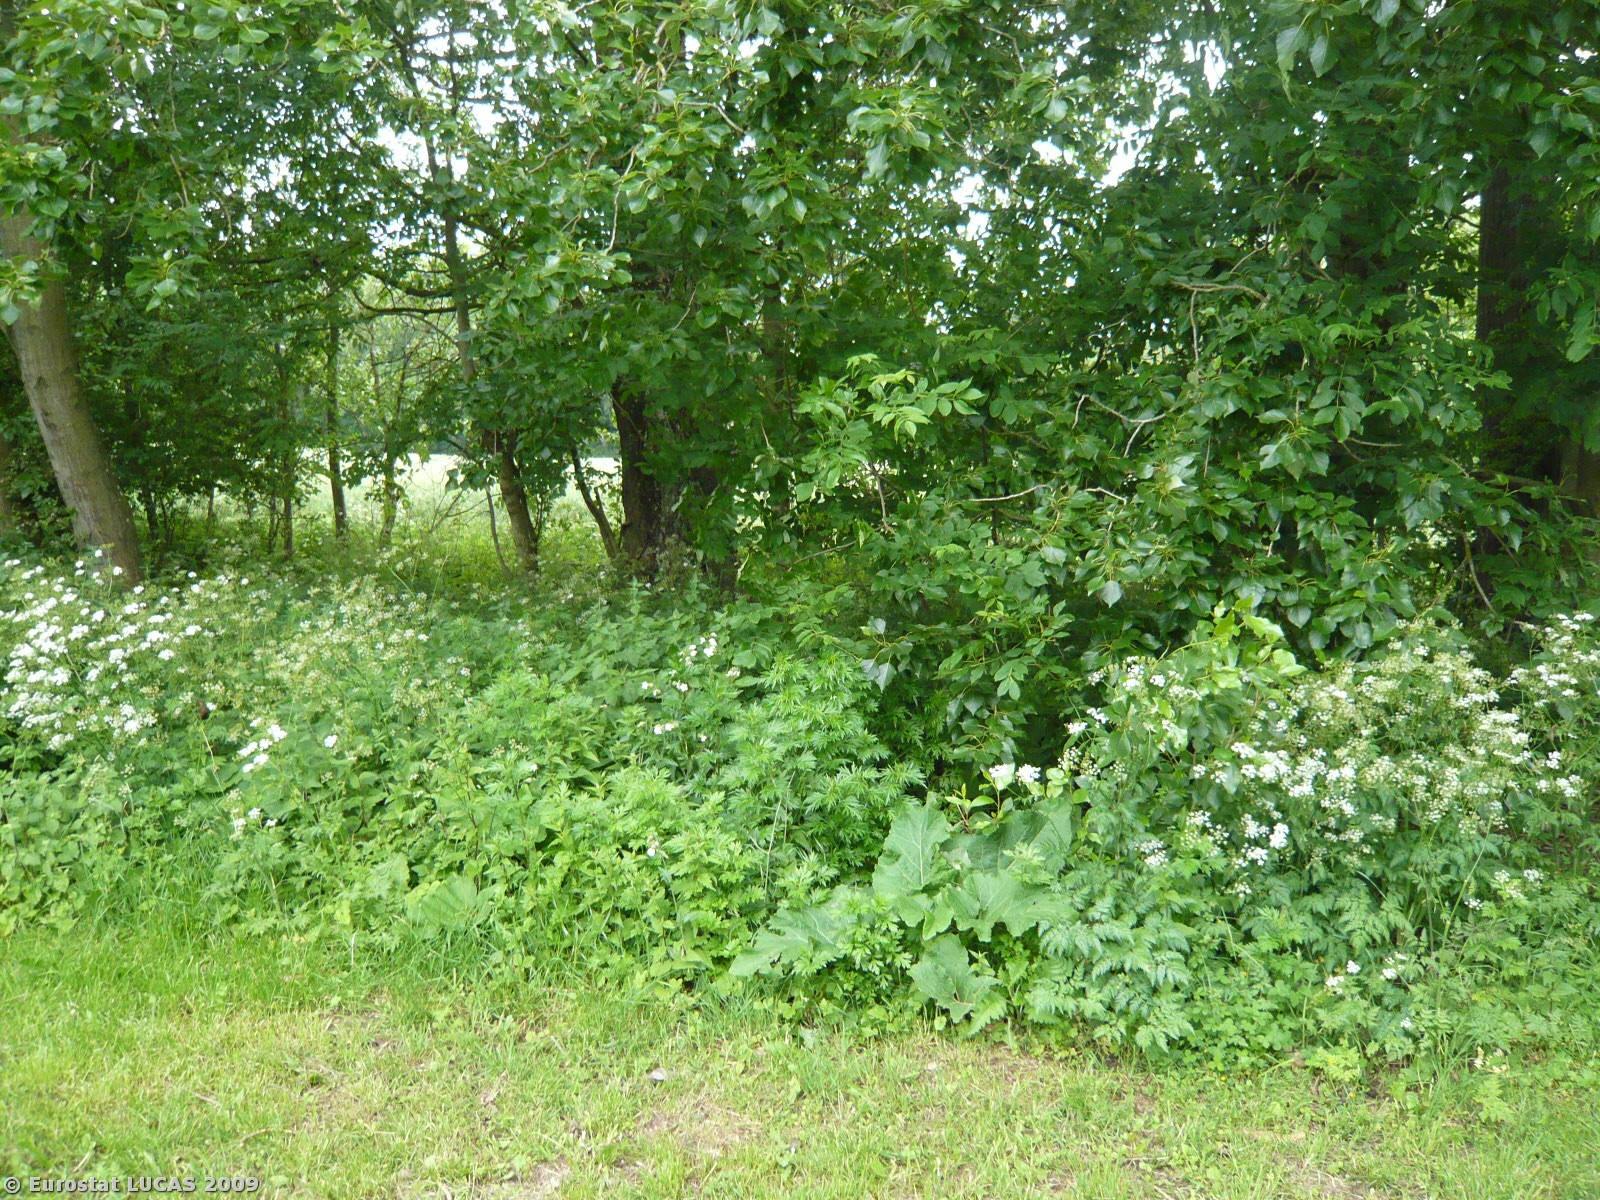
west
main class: Grassland
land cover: Grassland without tree/shrub cover
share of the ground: > 75 %
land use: Agriculture (excluding fallow land and kitchen gardens)
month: June
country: DK
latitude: 54.9323
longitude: 11.9496
